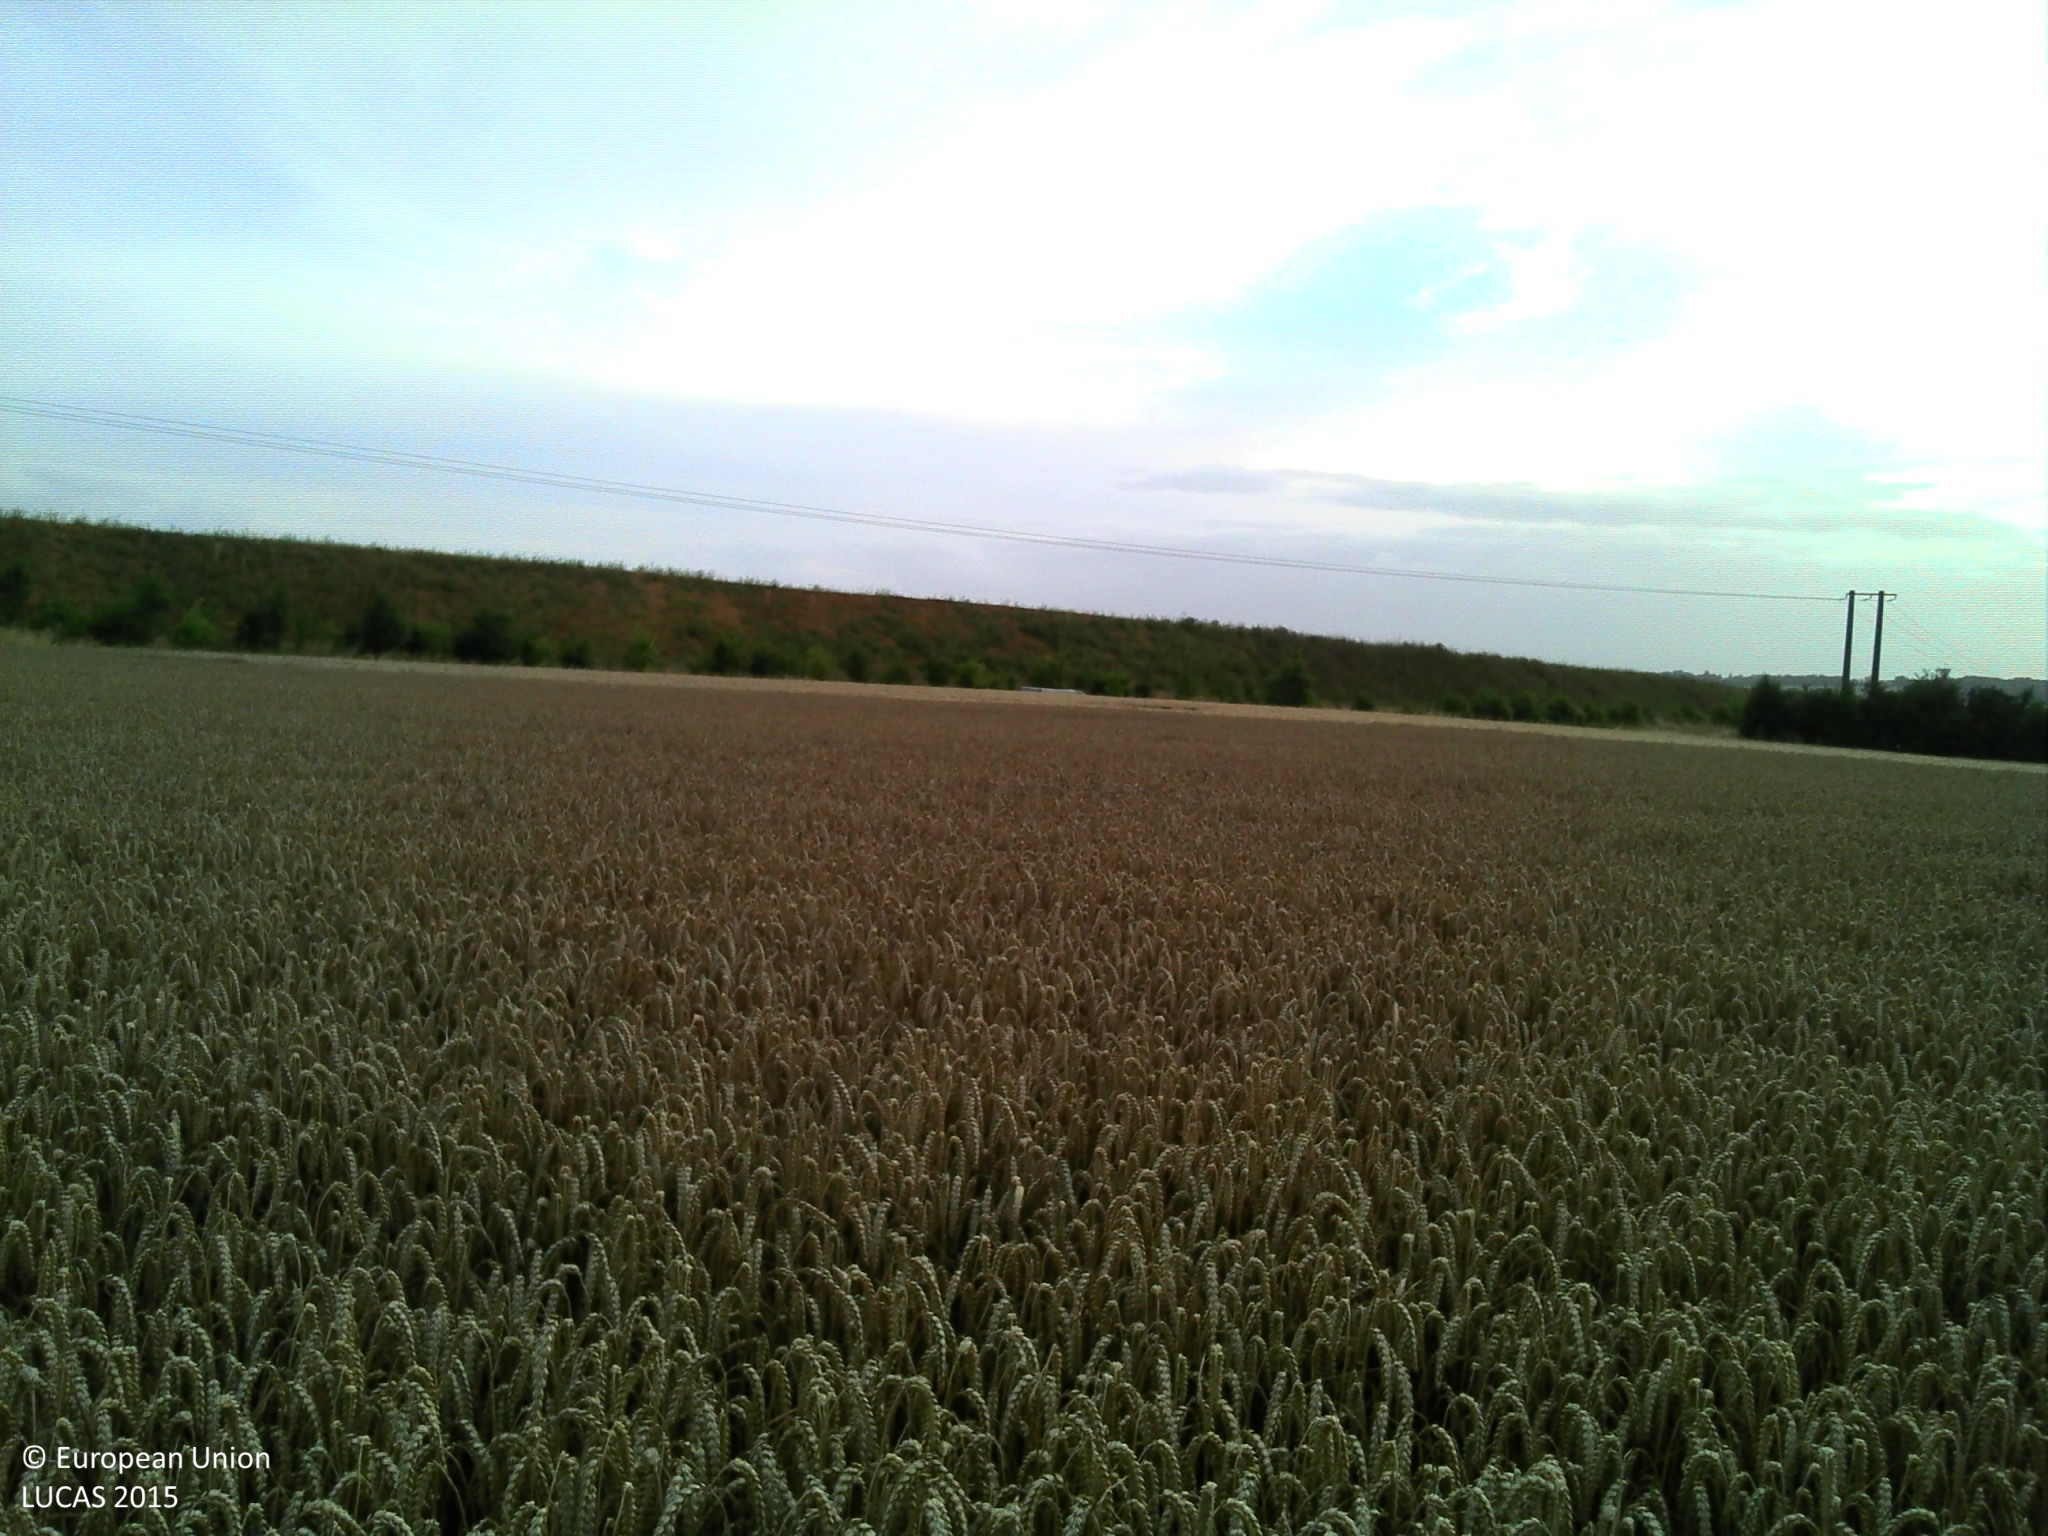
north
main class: Cropland
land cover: Common wheat
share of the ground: > 75 %
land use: Agriculture (excluding fallow land and kitchen gardens)
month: July
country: FR
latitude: 49.2124
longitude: -0.2608
